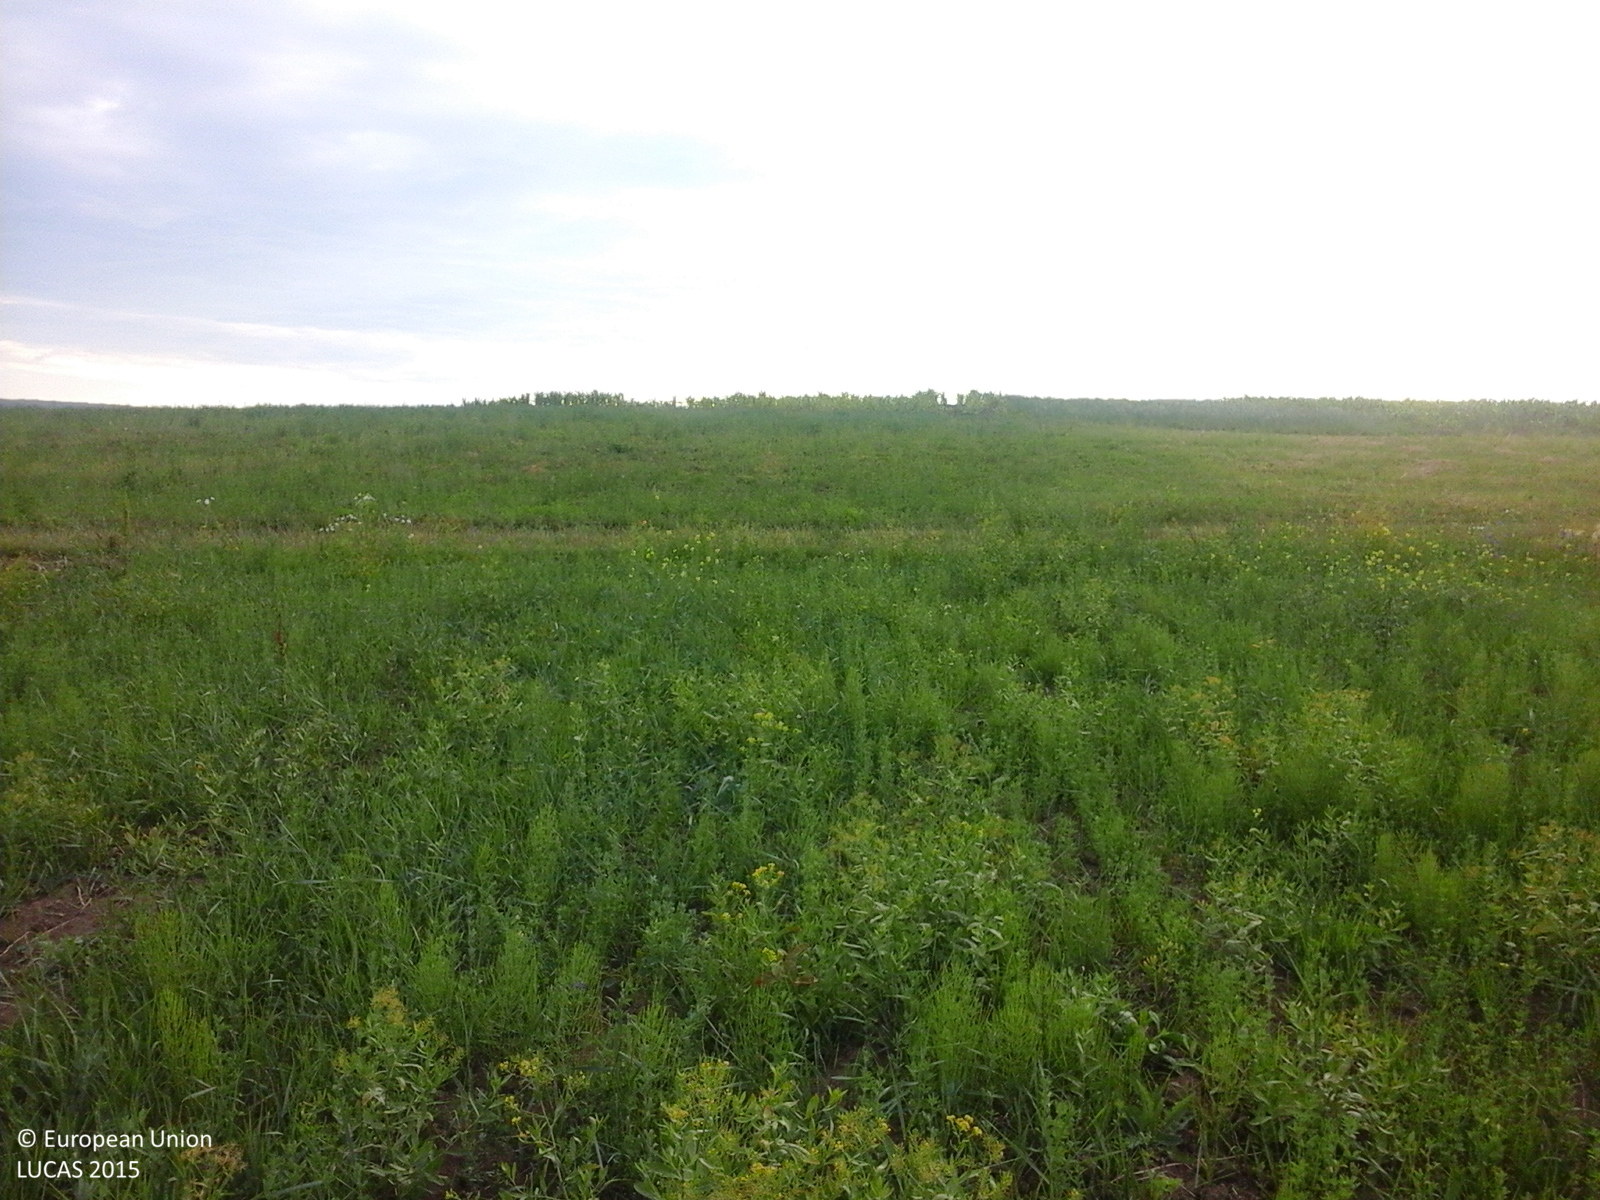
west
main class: Cropland
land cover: Other leguminous and mixtures for fodder
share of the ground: > 75 %
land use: Agriculture (excluding fallow land and kitchen gardens)
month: June
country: RO
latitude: 47.4957
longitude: 26.5365
